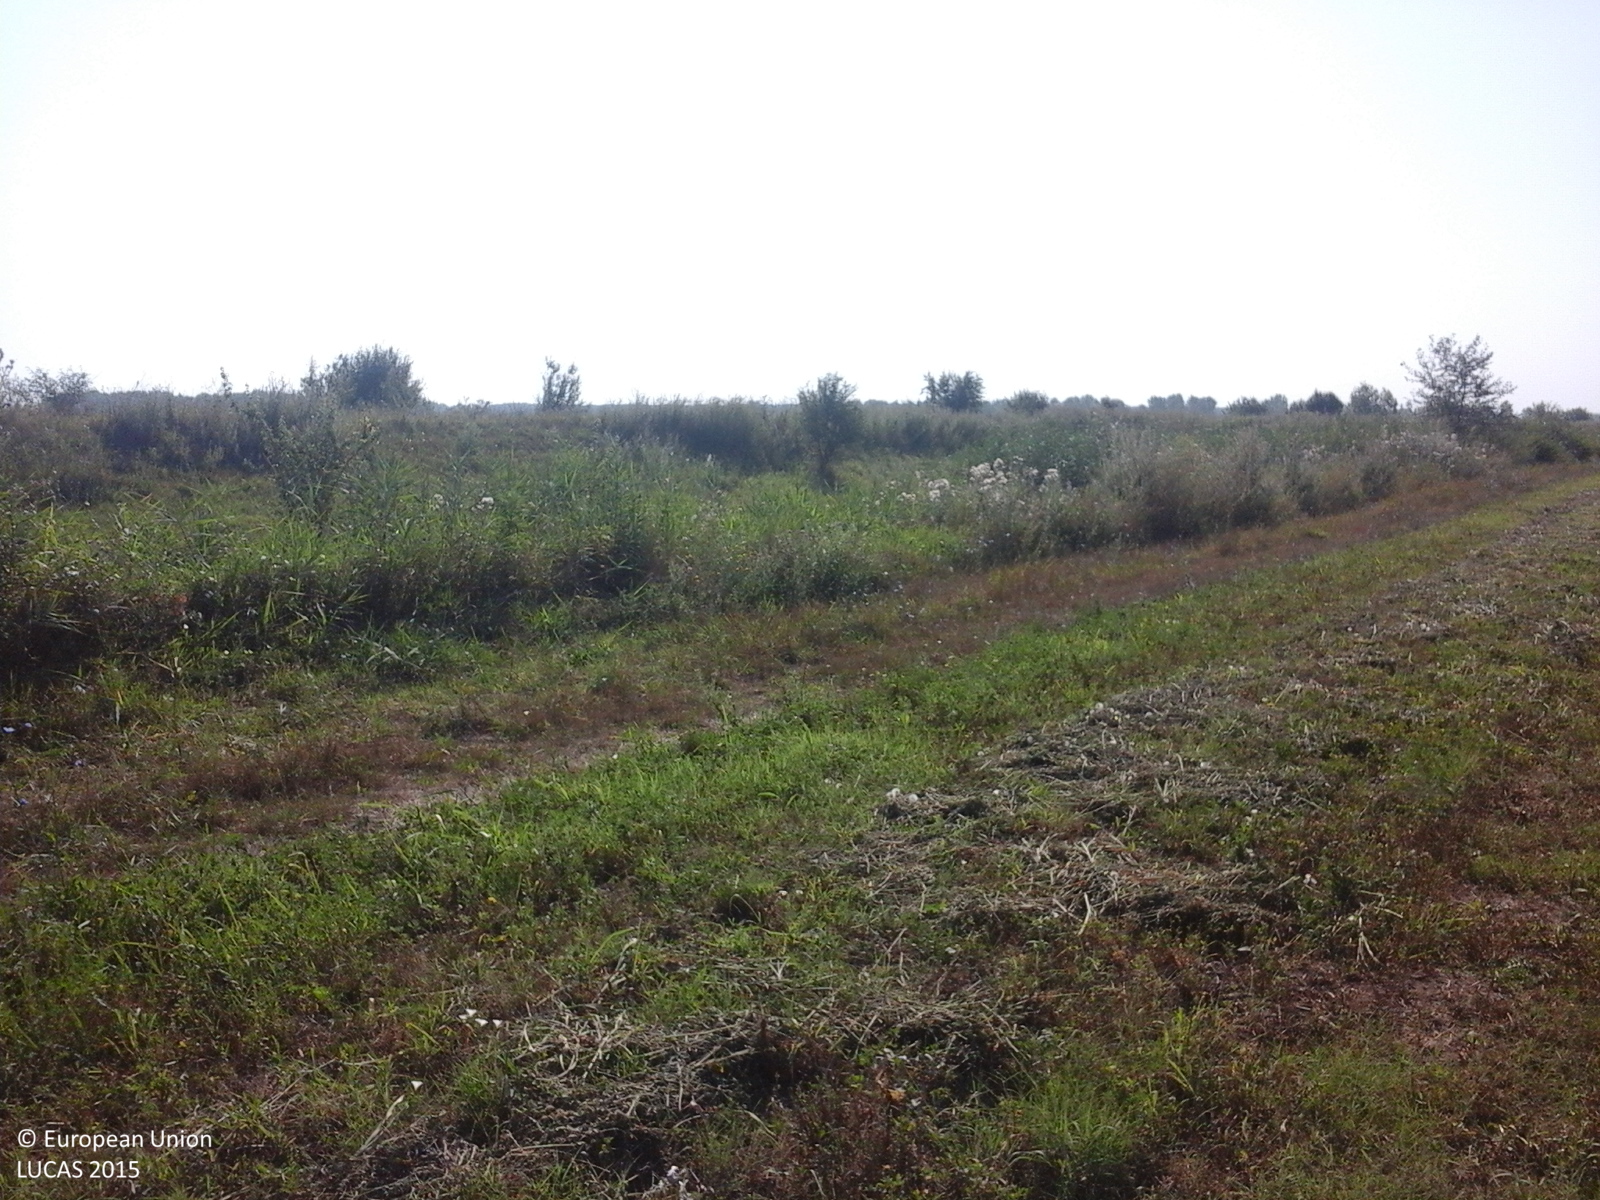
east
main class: Cropland
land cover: Lucerne
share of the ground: > 75 %
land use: Agriculture (excluding fallow land and kitchen gardens)
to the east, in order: Lucerne; Tracks; Shruby margins; Ditches and canals; Abandoned hedges; Tracks; Grass margins; Single bushes/trees; Ditches and canals; Shruby margins; Maize
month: July
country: RO
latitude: 44.1890
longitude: 26.8738
